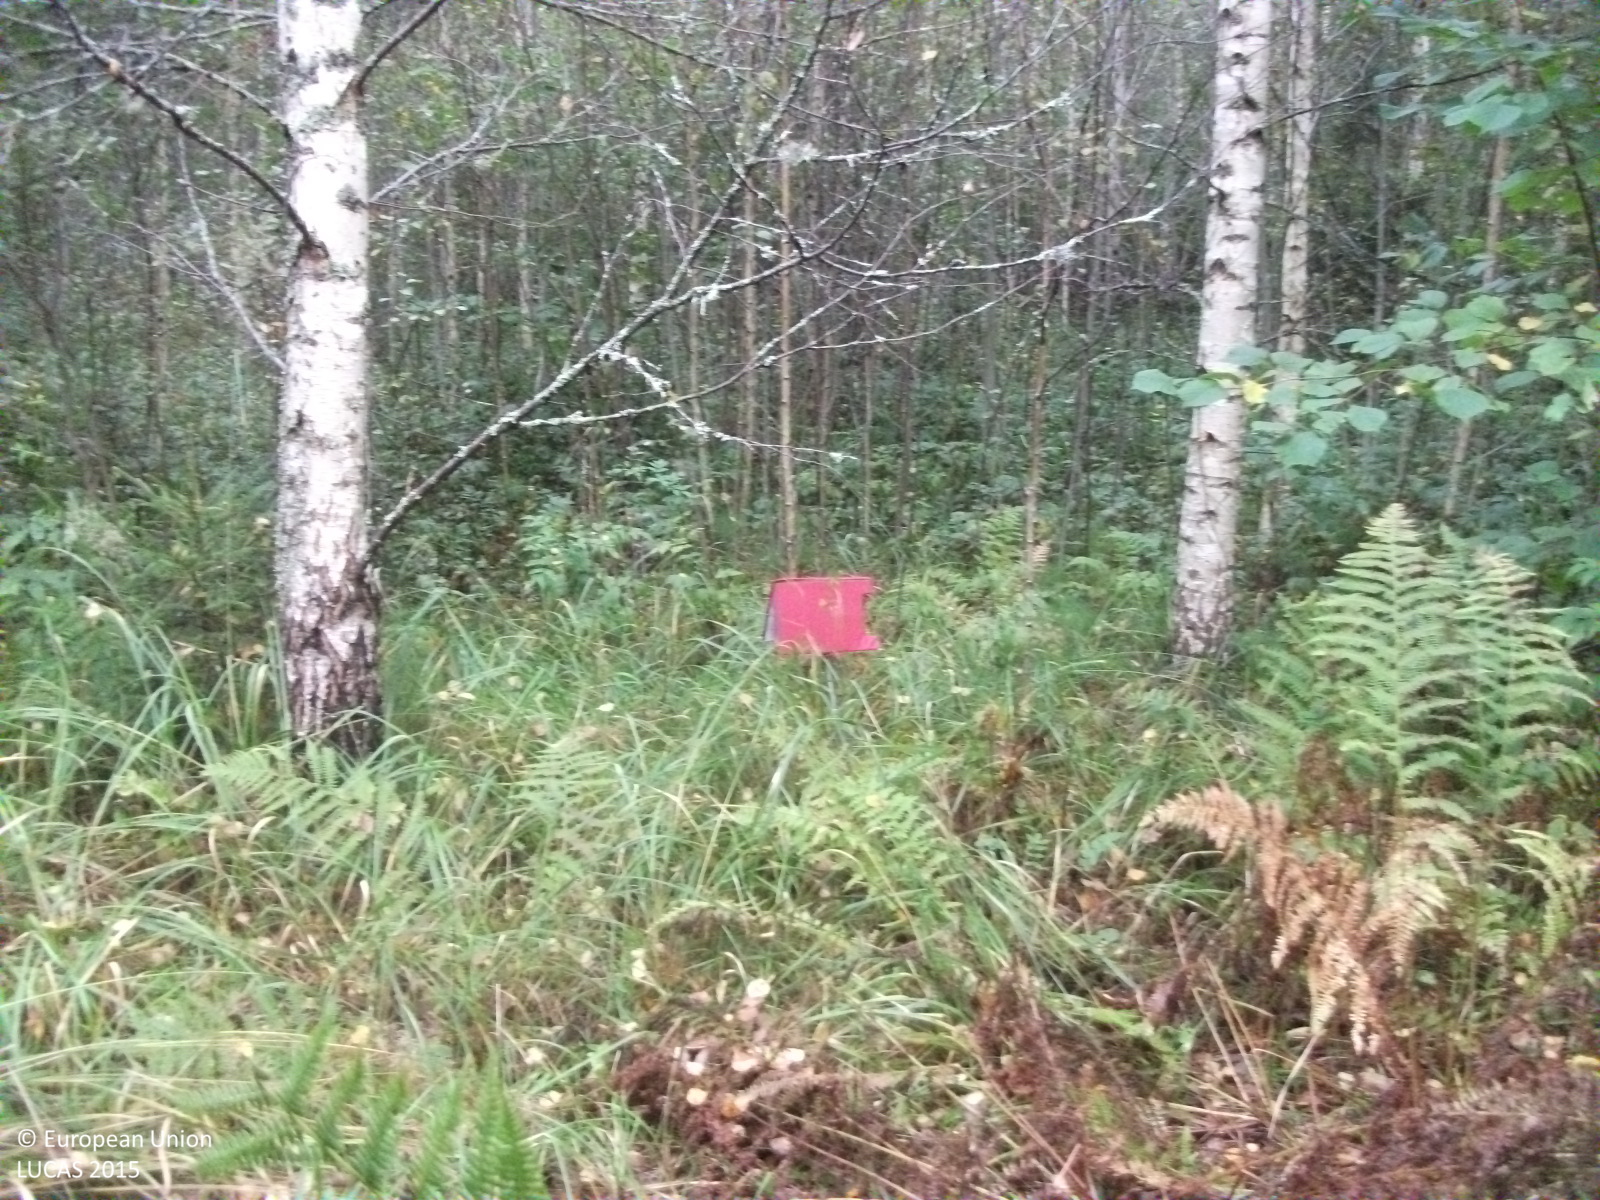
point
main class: Woodland
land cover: Broadleaved woodland
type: non-riverine alder, birch or aspen forest
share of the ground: > 75 %
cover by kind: broadleaved forest trees 80 %, shrubs 10 %, herbaceous plants 10 %
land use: Forestry
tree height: > 5 m
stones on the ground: < 10 %
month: September
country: LV
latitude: 57.6621
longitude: 24.6939
